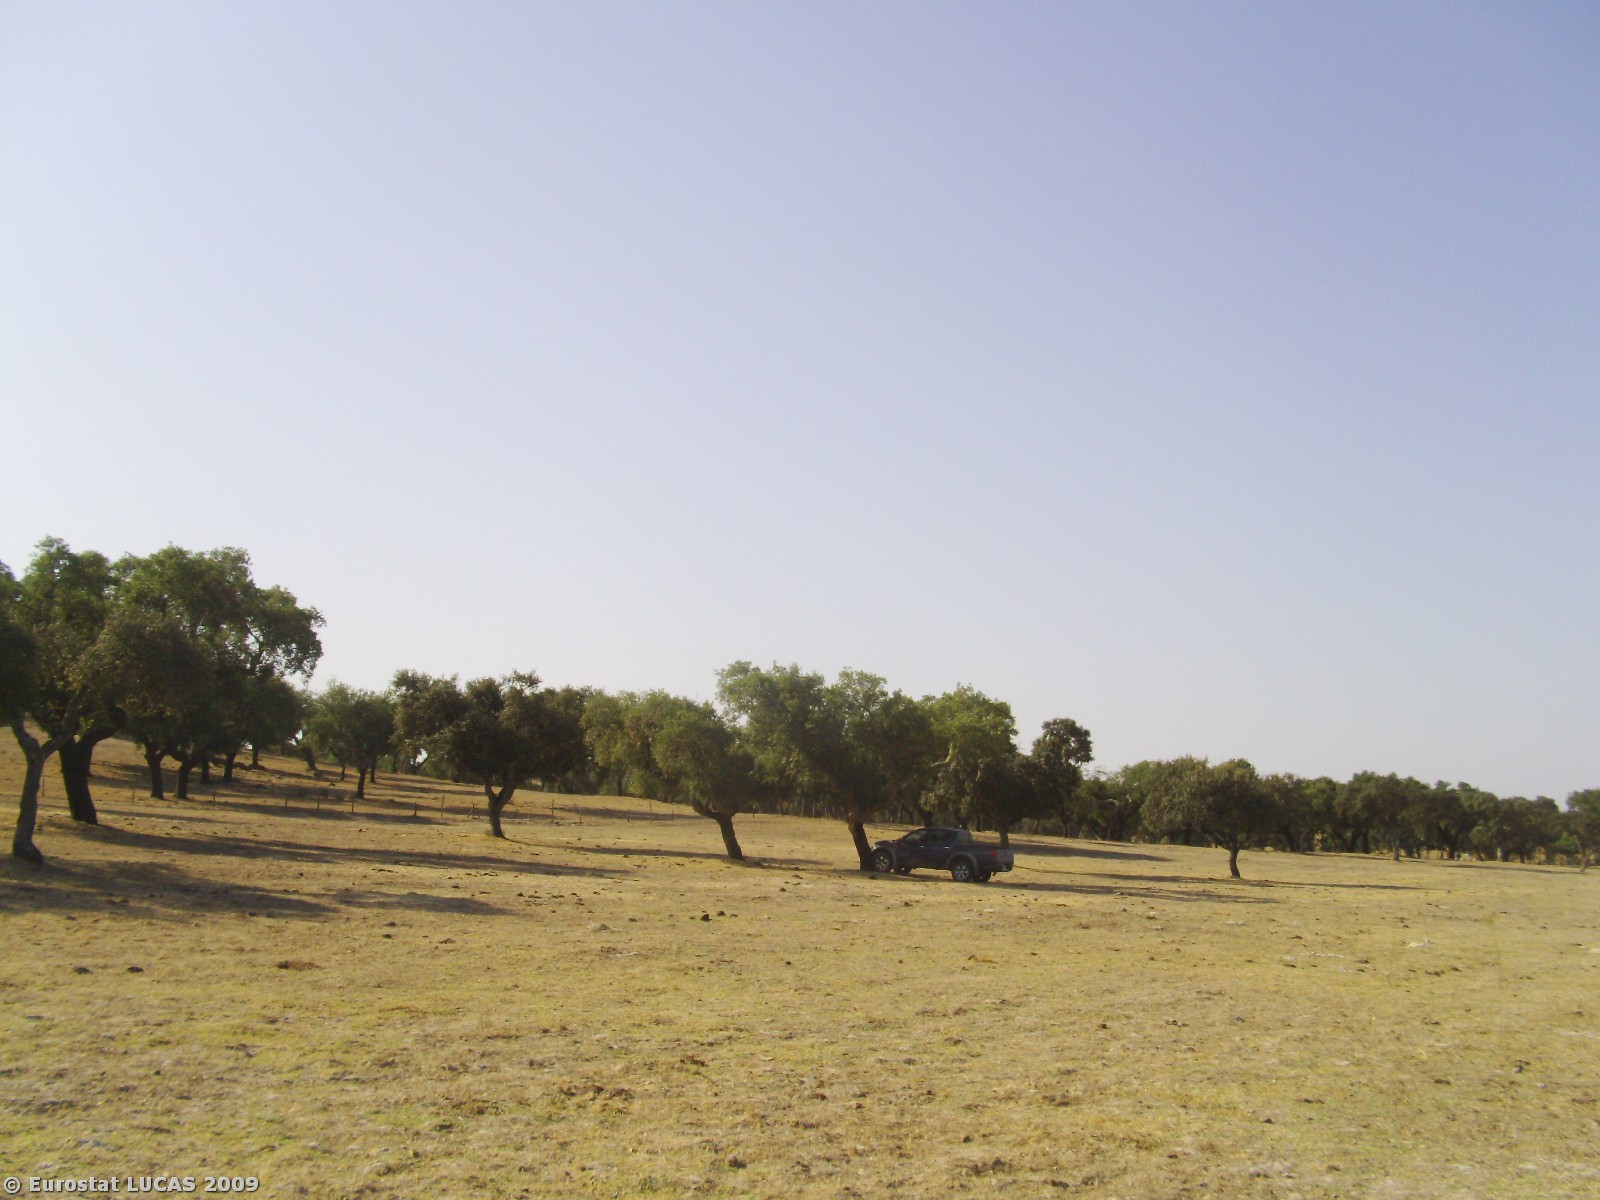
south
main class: Grassland
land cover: Grassland without tree/shrub cover
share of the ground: < 10 %
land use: Agriculture (excluding fallow land and kitchen gardens)
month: August
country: PT
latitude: 38.4139
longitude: -7.9378
